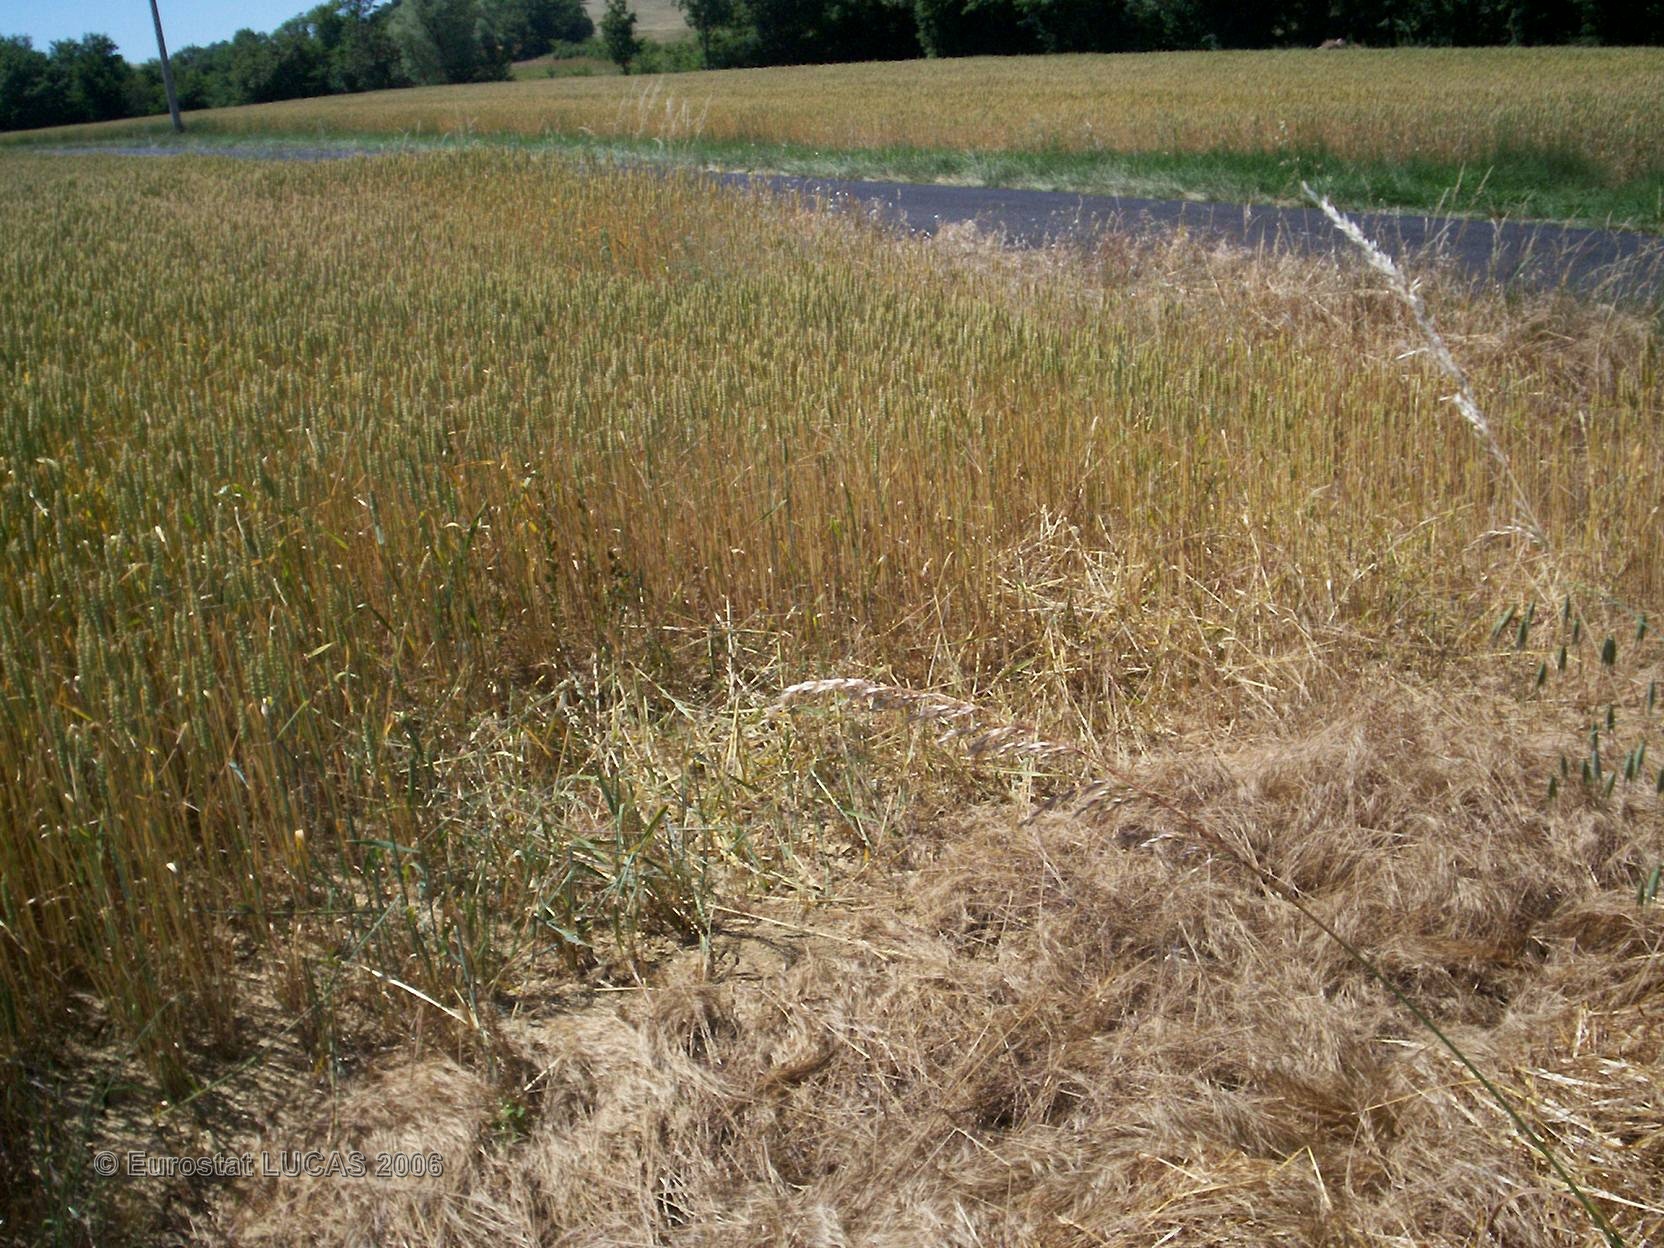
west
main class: Grassland
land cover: Grassland without tree/shrub cover
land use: Unused
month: June
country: FR
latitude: 43.7972
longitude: 0.8134
